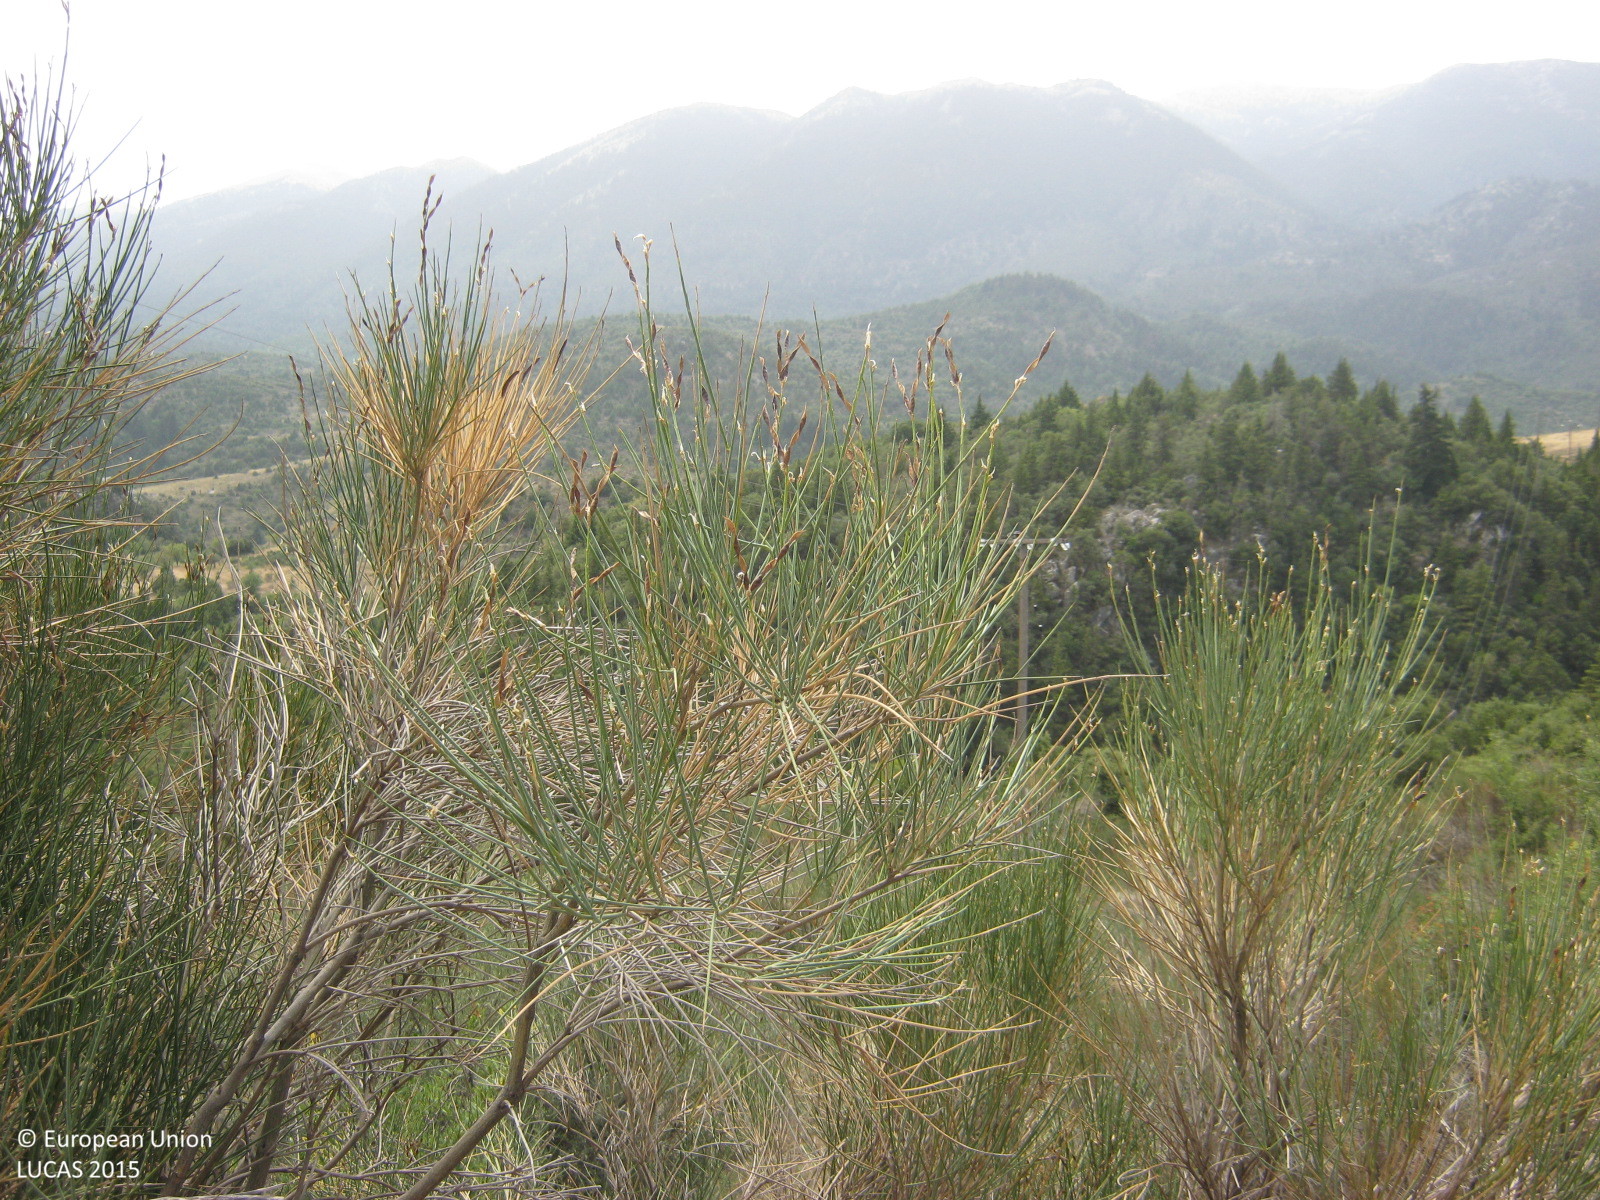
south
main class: Woodland
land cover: Spruce dominated coniferous woodland
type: coniferous forest of the mediterranean region
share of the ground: > 75 %
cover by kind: coniferous forest trees 90 %, unconsolidated bare surface 10 %
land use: Forestry
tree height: > 5 m
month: September
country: GR
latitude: 37.1888
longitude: 22.6774
